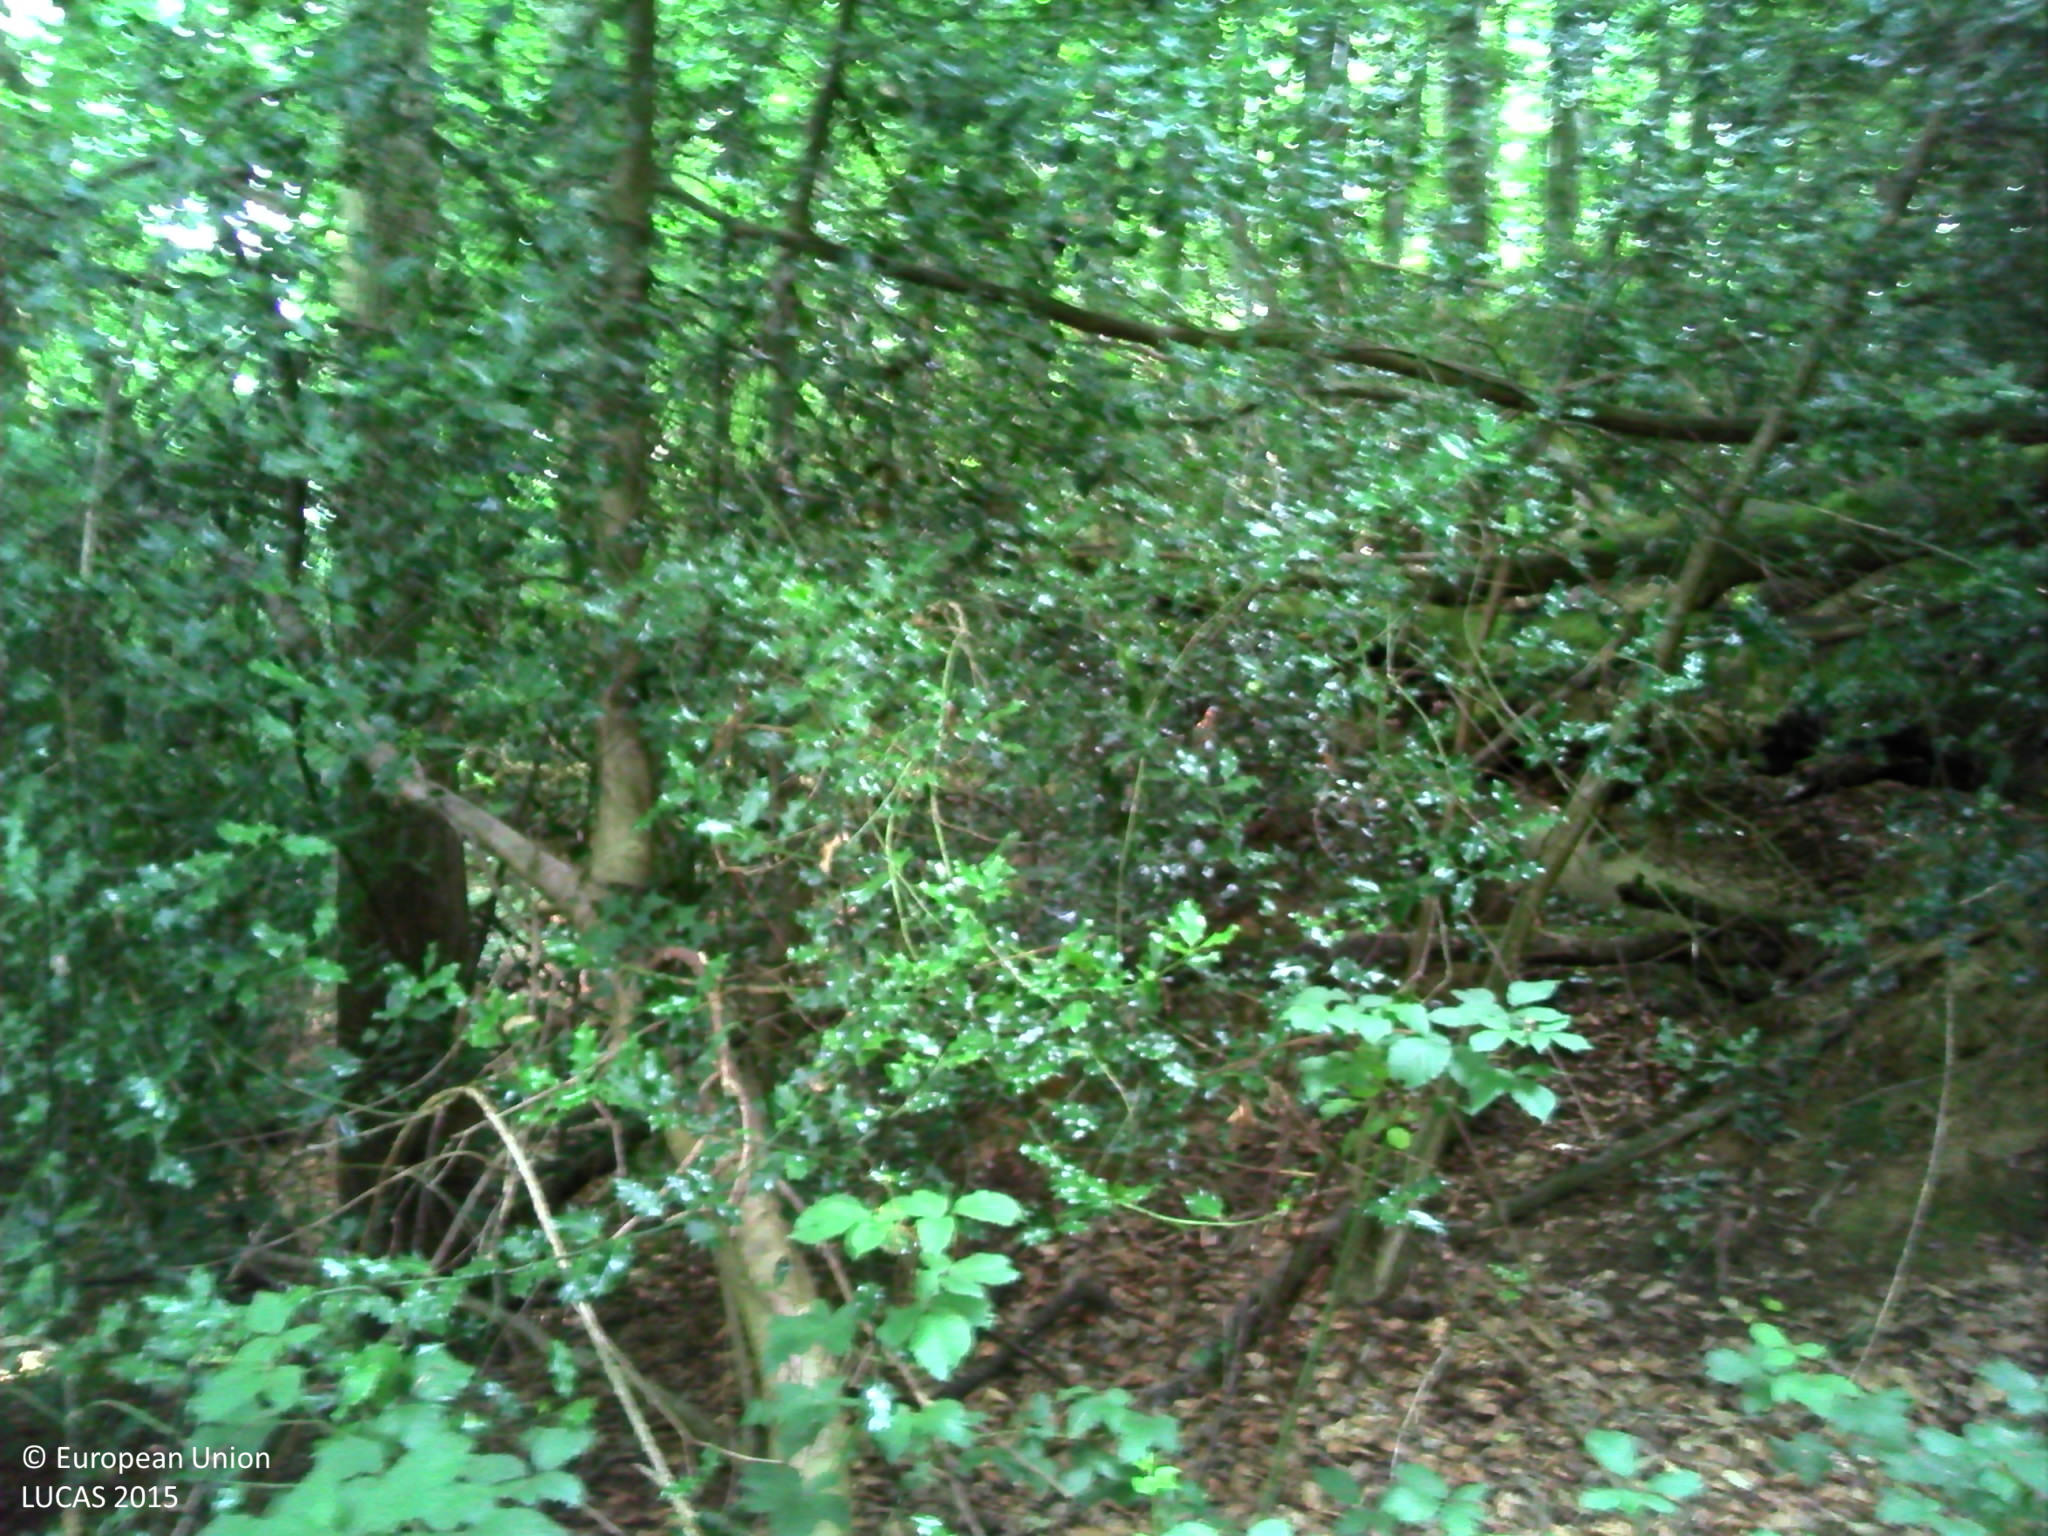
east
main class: Woodland
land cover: Broadleaved woodland
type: beech forest
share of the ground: > 75 %
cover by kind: broadleaved forest trees 95 %, shrubs 5 %
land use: Forestry
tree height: > 5 m
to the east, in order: Broadleaved woodland; Rivers and streams; Broadleaved woodland; Tracks; Broadleaved woodland
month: August
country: FR
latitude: 48.6961
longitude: -1.2806
